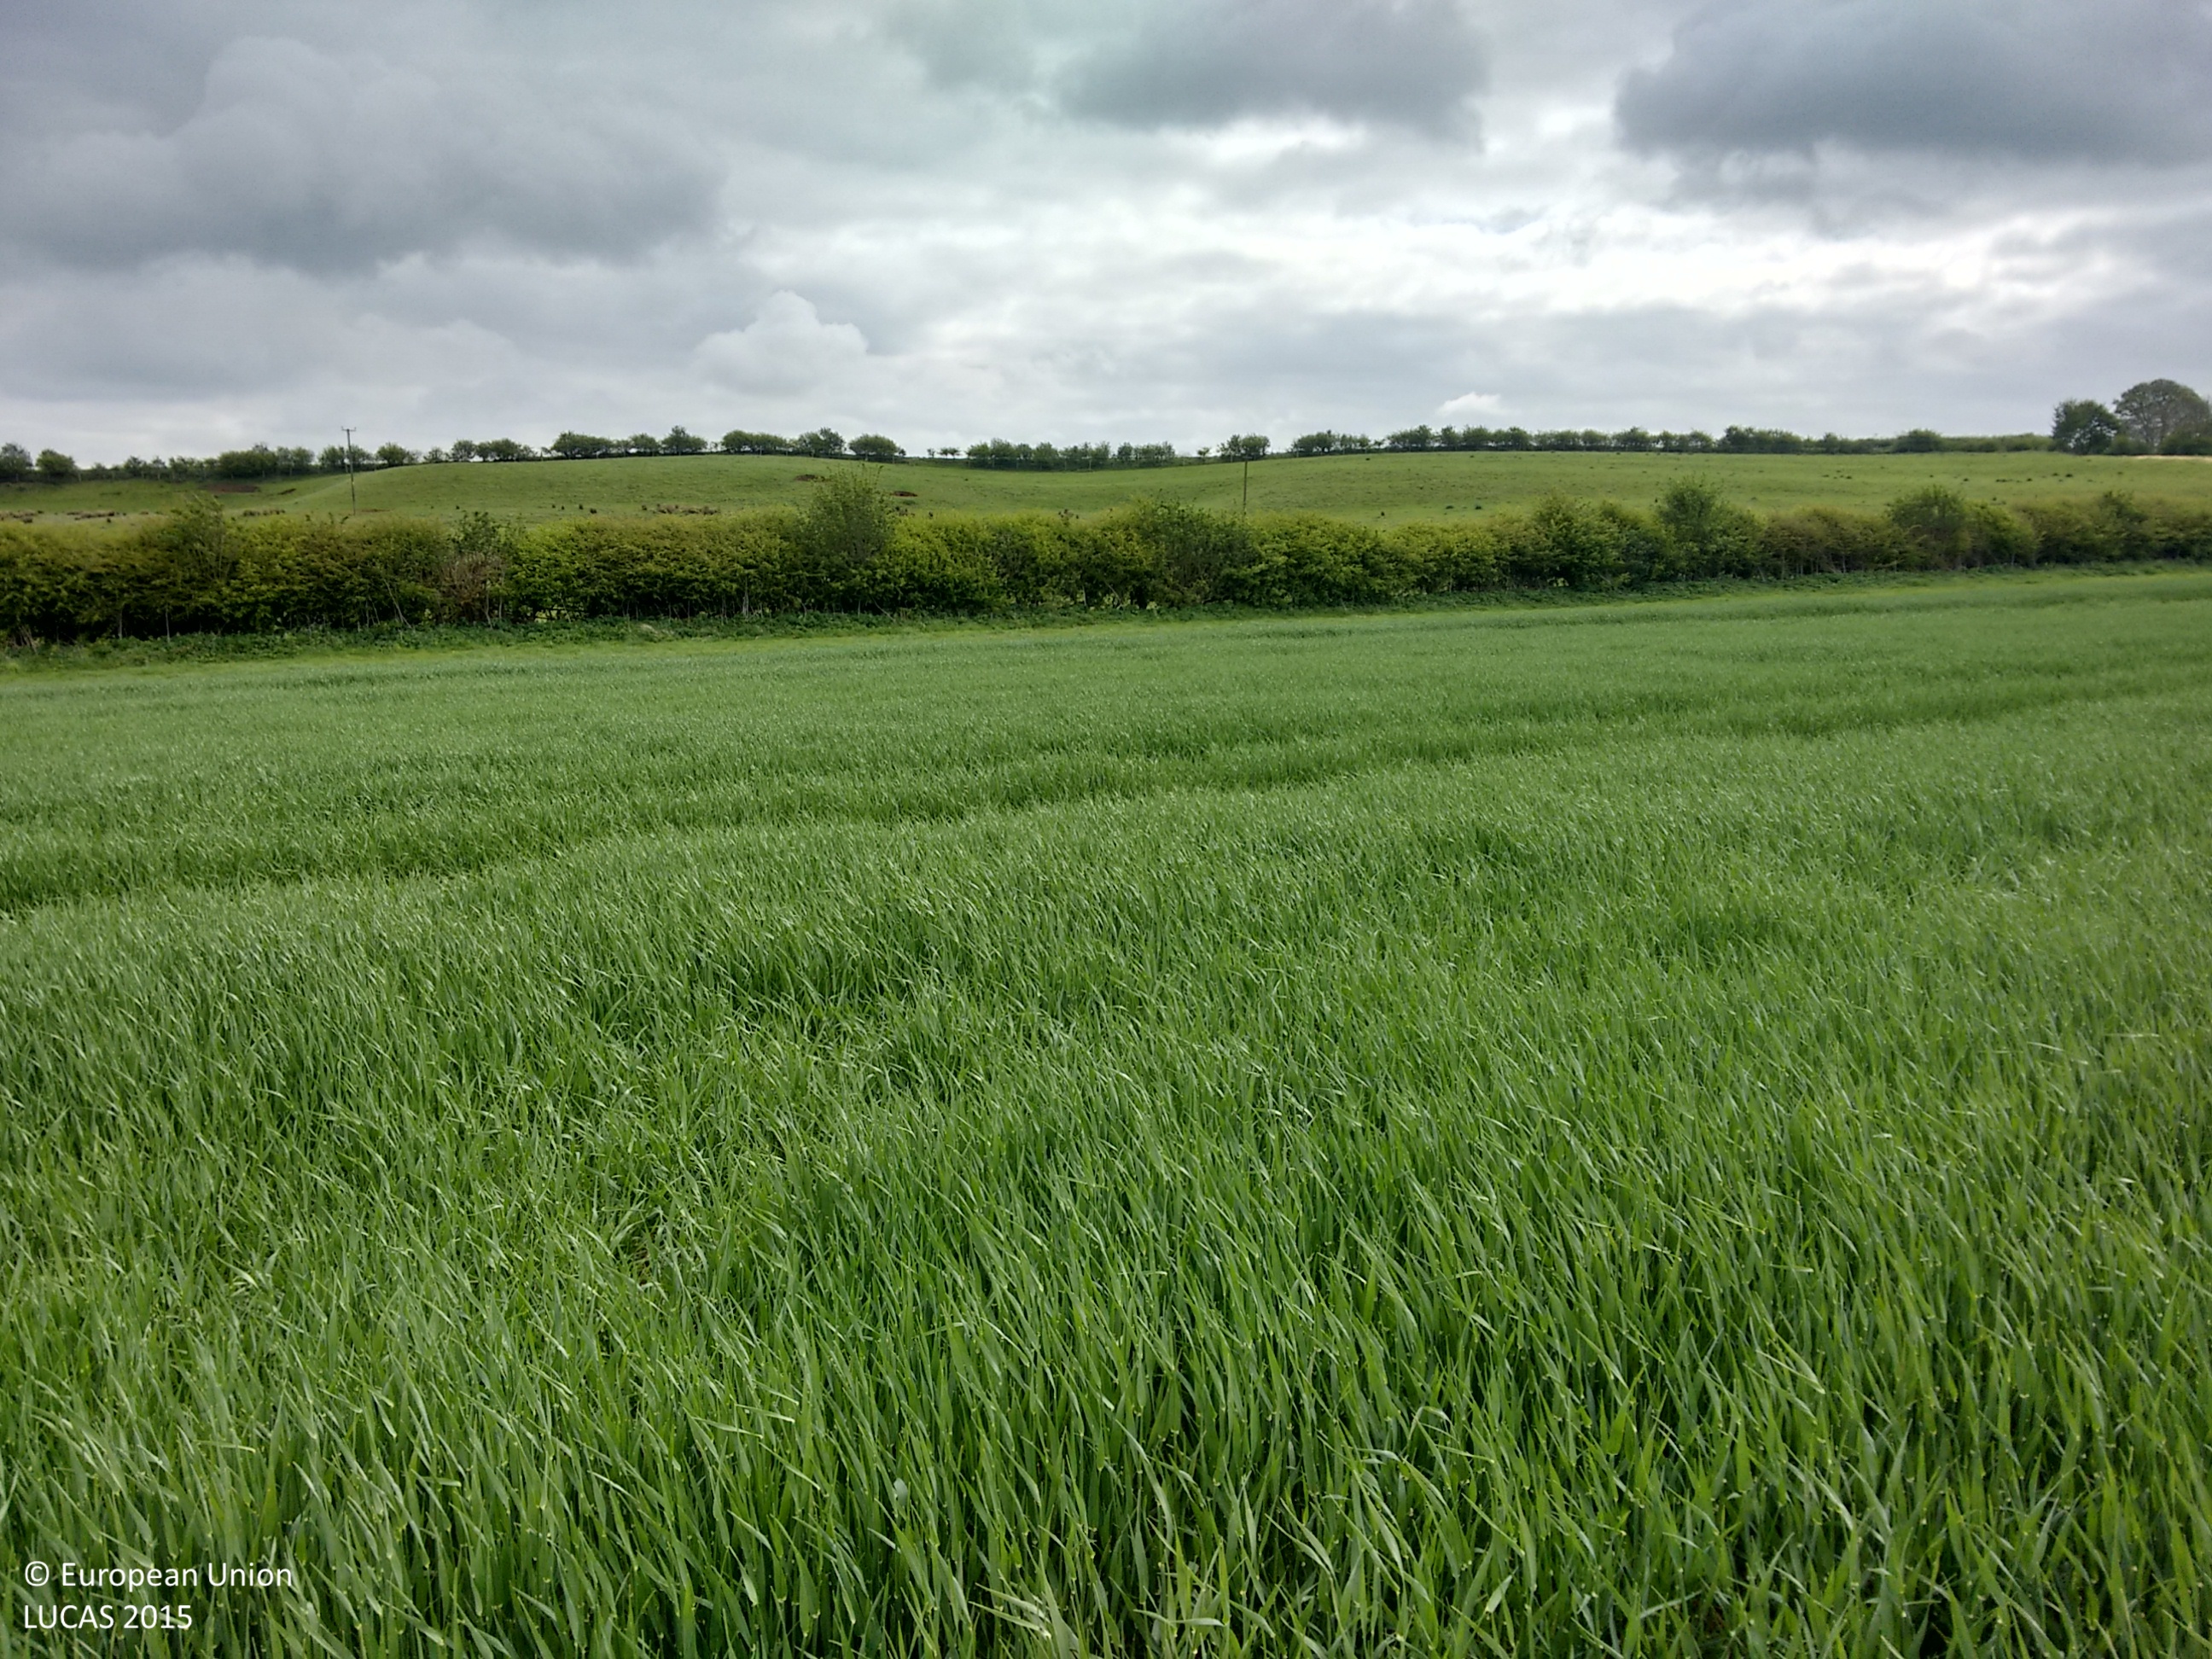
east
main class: Cropland
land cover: Barley
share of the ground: > 75 %
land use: Agriculture (excluding fallow land and kitchen gardens)
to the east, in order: Barley; Grass margins; Managed hedges; Fences; Grassland without tree/shrub cover; Electric lines; Grassland without tree/shrub cover; Fences; Managed hedges; Grass margins; Common wheat
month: May
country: GB
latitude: 53.3377
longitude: -0.1406
